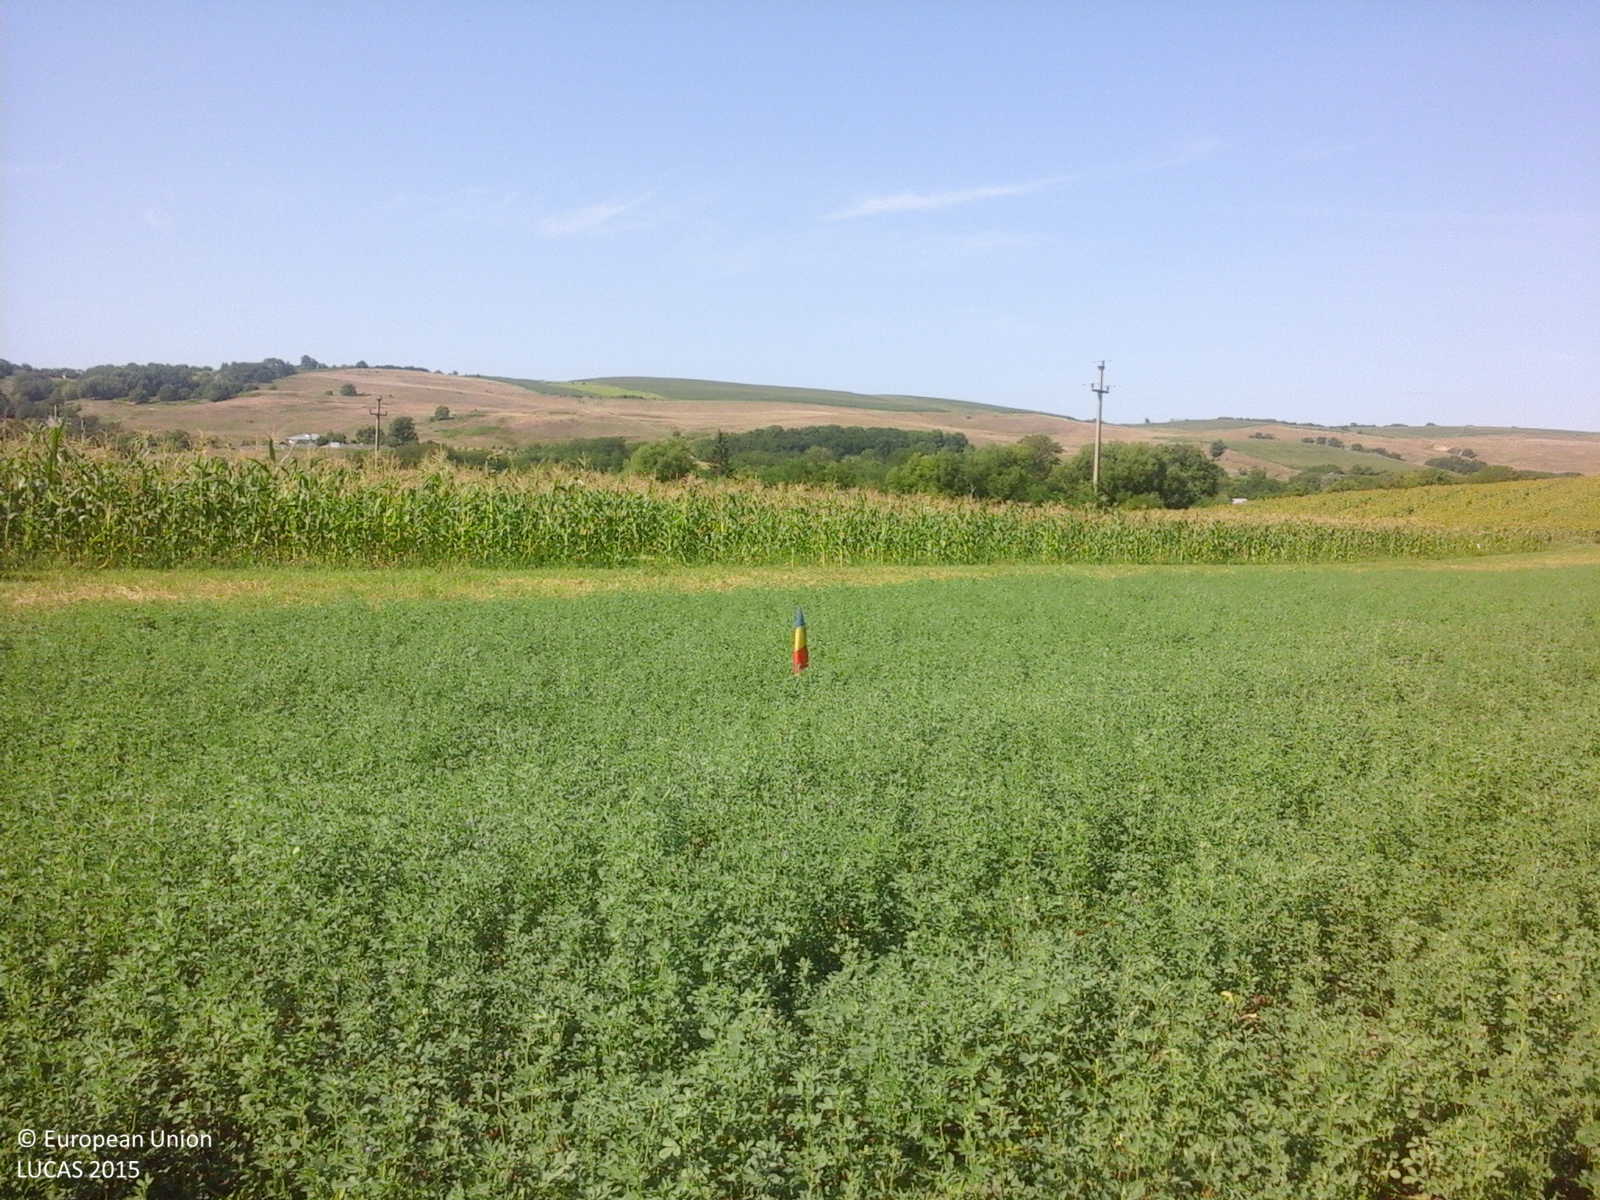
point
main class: Cropland
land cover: Lucerne
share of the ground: > 75 %
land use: Agriculture (excluding fallow land and kitchen gardens)
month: July
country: RO
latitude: 46.1979
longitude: 27.2984
